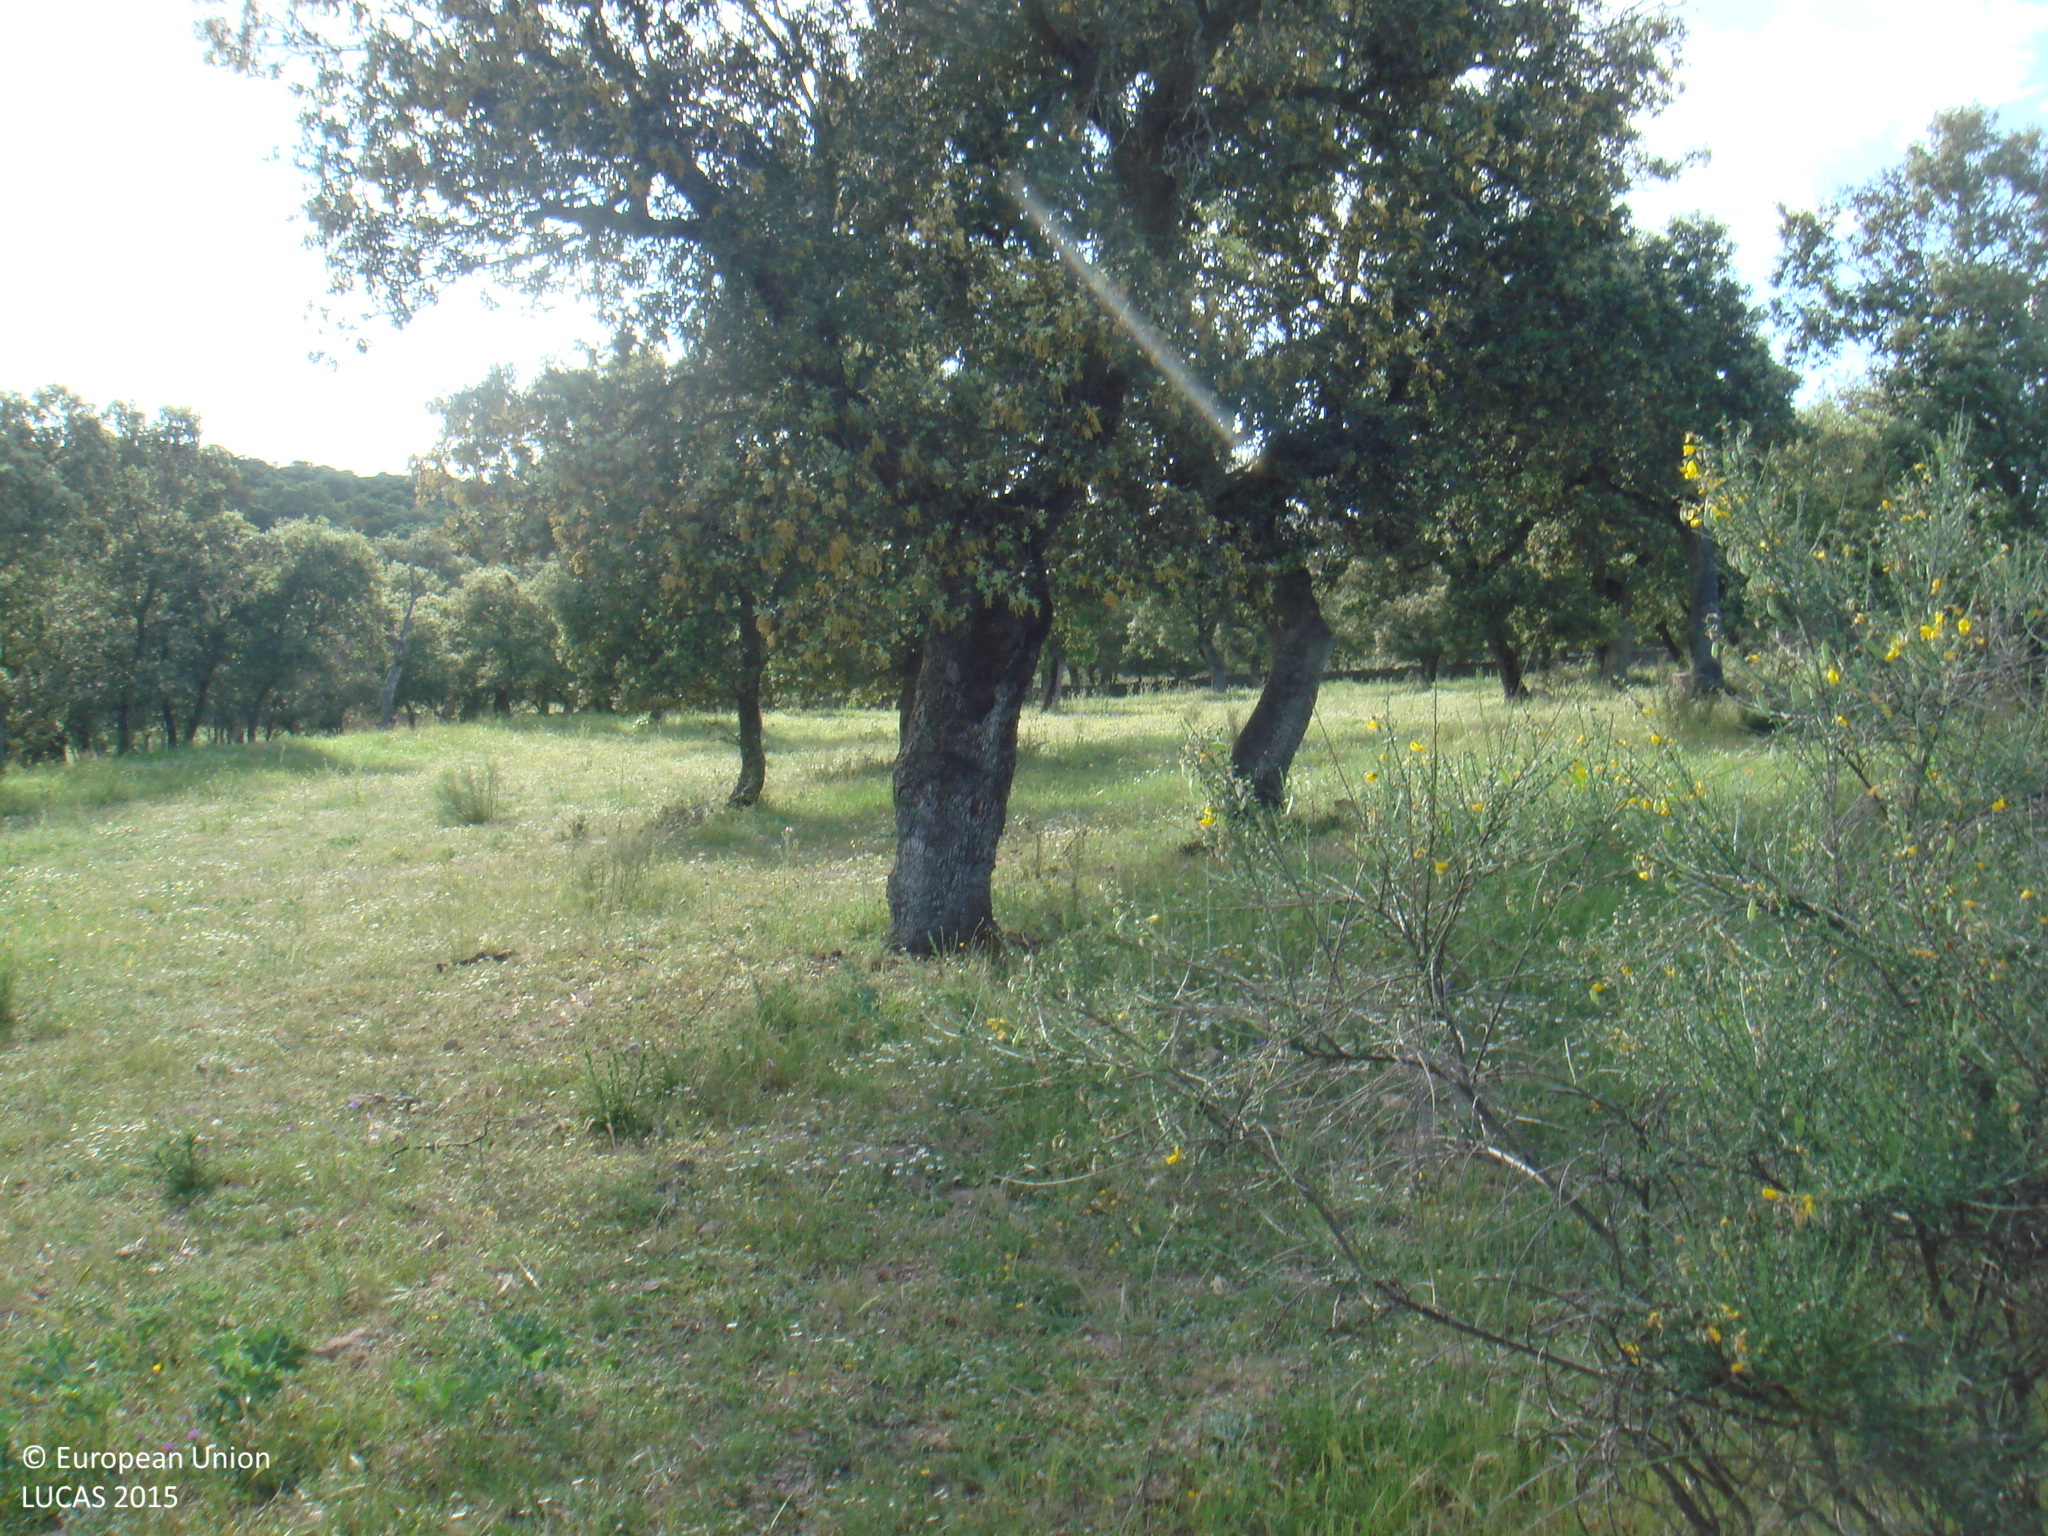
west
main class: Woodland
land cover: Broadleaved woodland
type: broadleaved evergreen forest
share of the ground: 10 - 25 %
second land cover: Shrubland without tree cover
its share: 10 - 25 %
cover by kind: herbaceous plants 70 %, broadleaved forest trees 20 %, shrubs 10 %
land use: Forestry
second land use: Fallow land
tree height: > 5 m
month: May
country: ES
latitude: 38.3771
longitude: -4.7311
